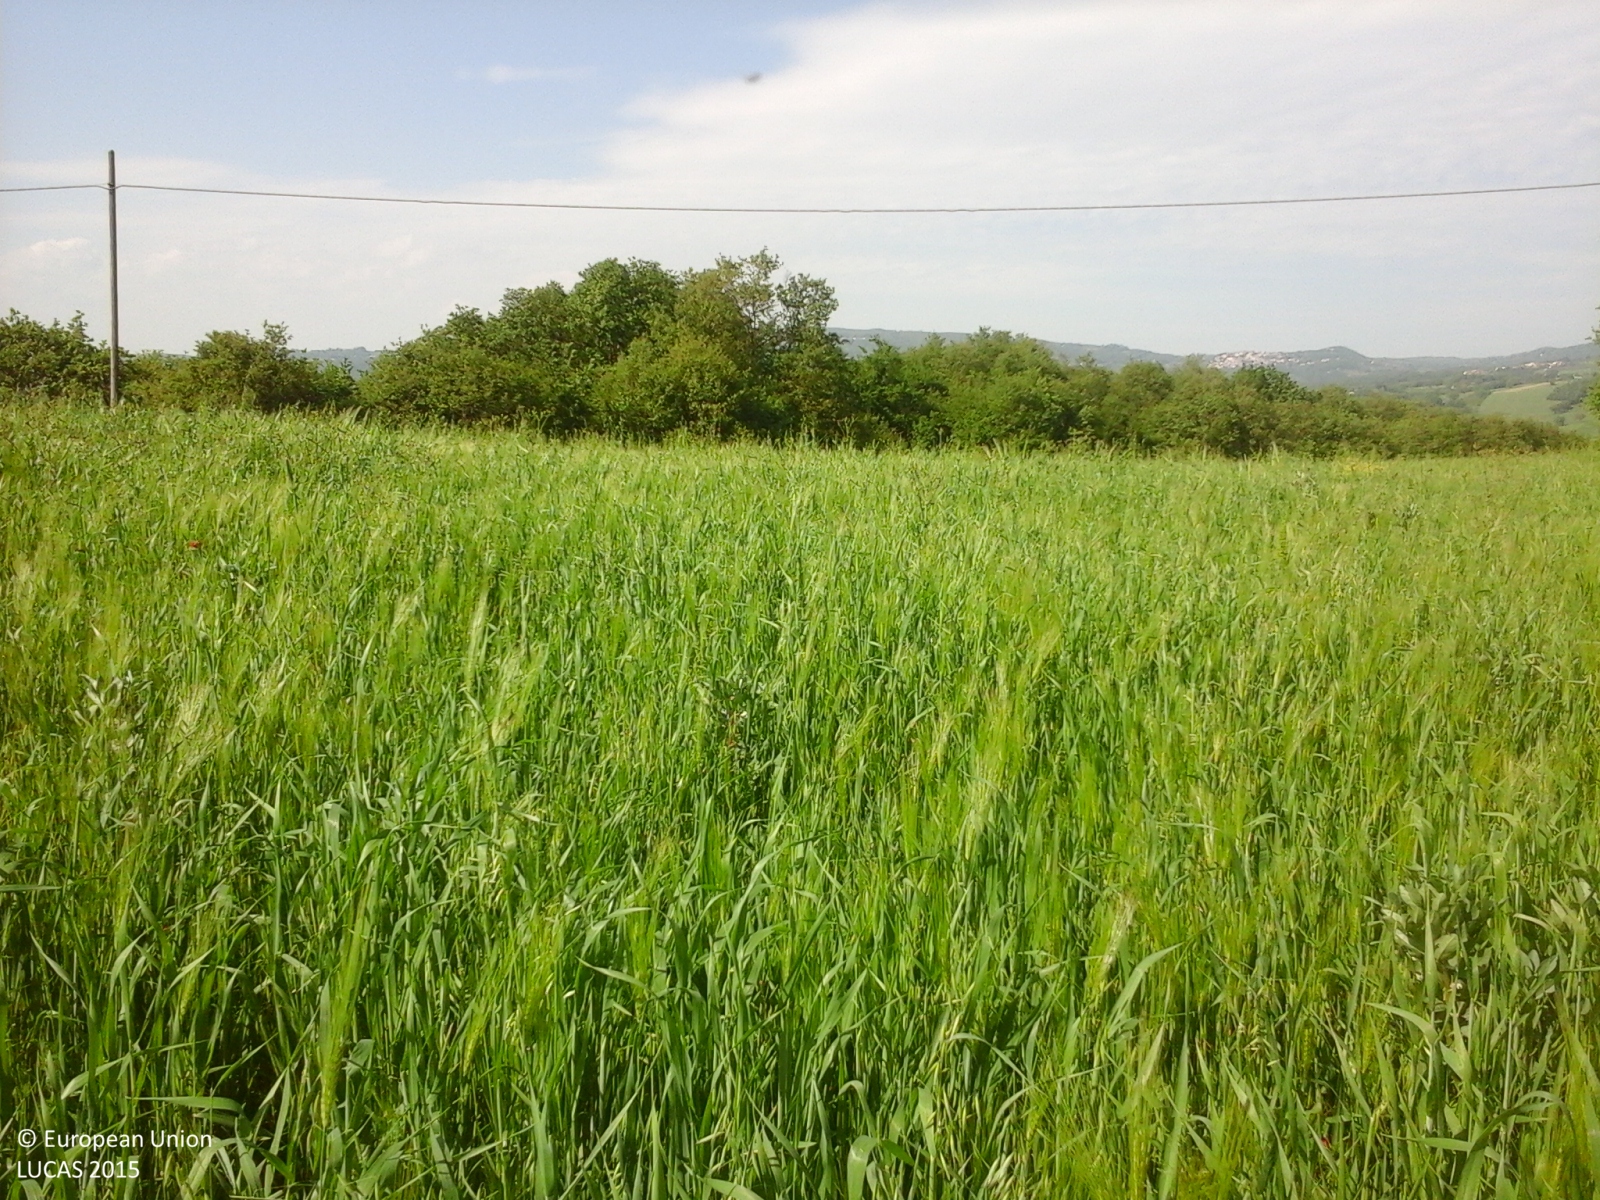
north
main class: Cropland
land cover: Barley
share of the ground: > 75 %
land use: Agriculture (excluding fallow land and kitchen gardens)
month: May
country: IT
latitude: 41.3323
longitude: 14.7026
